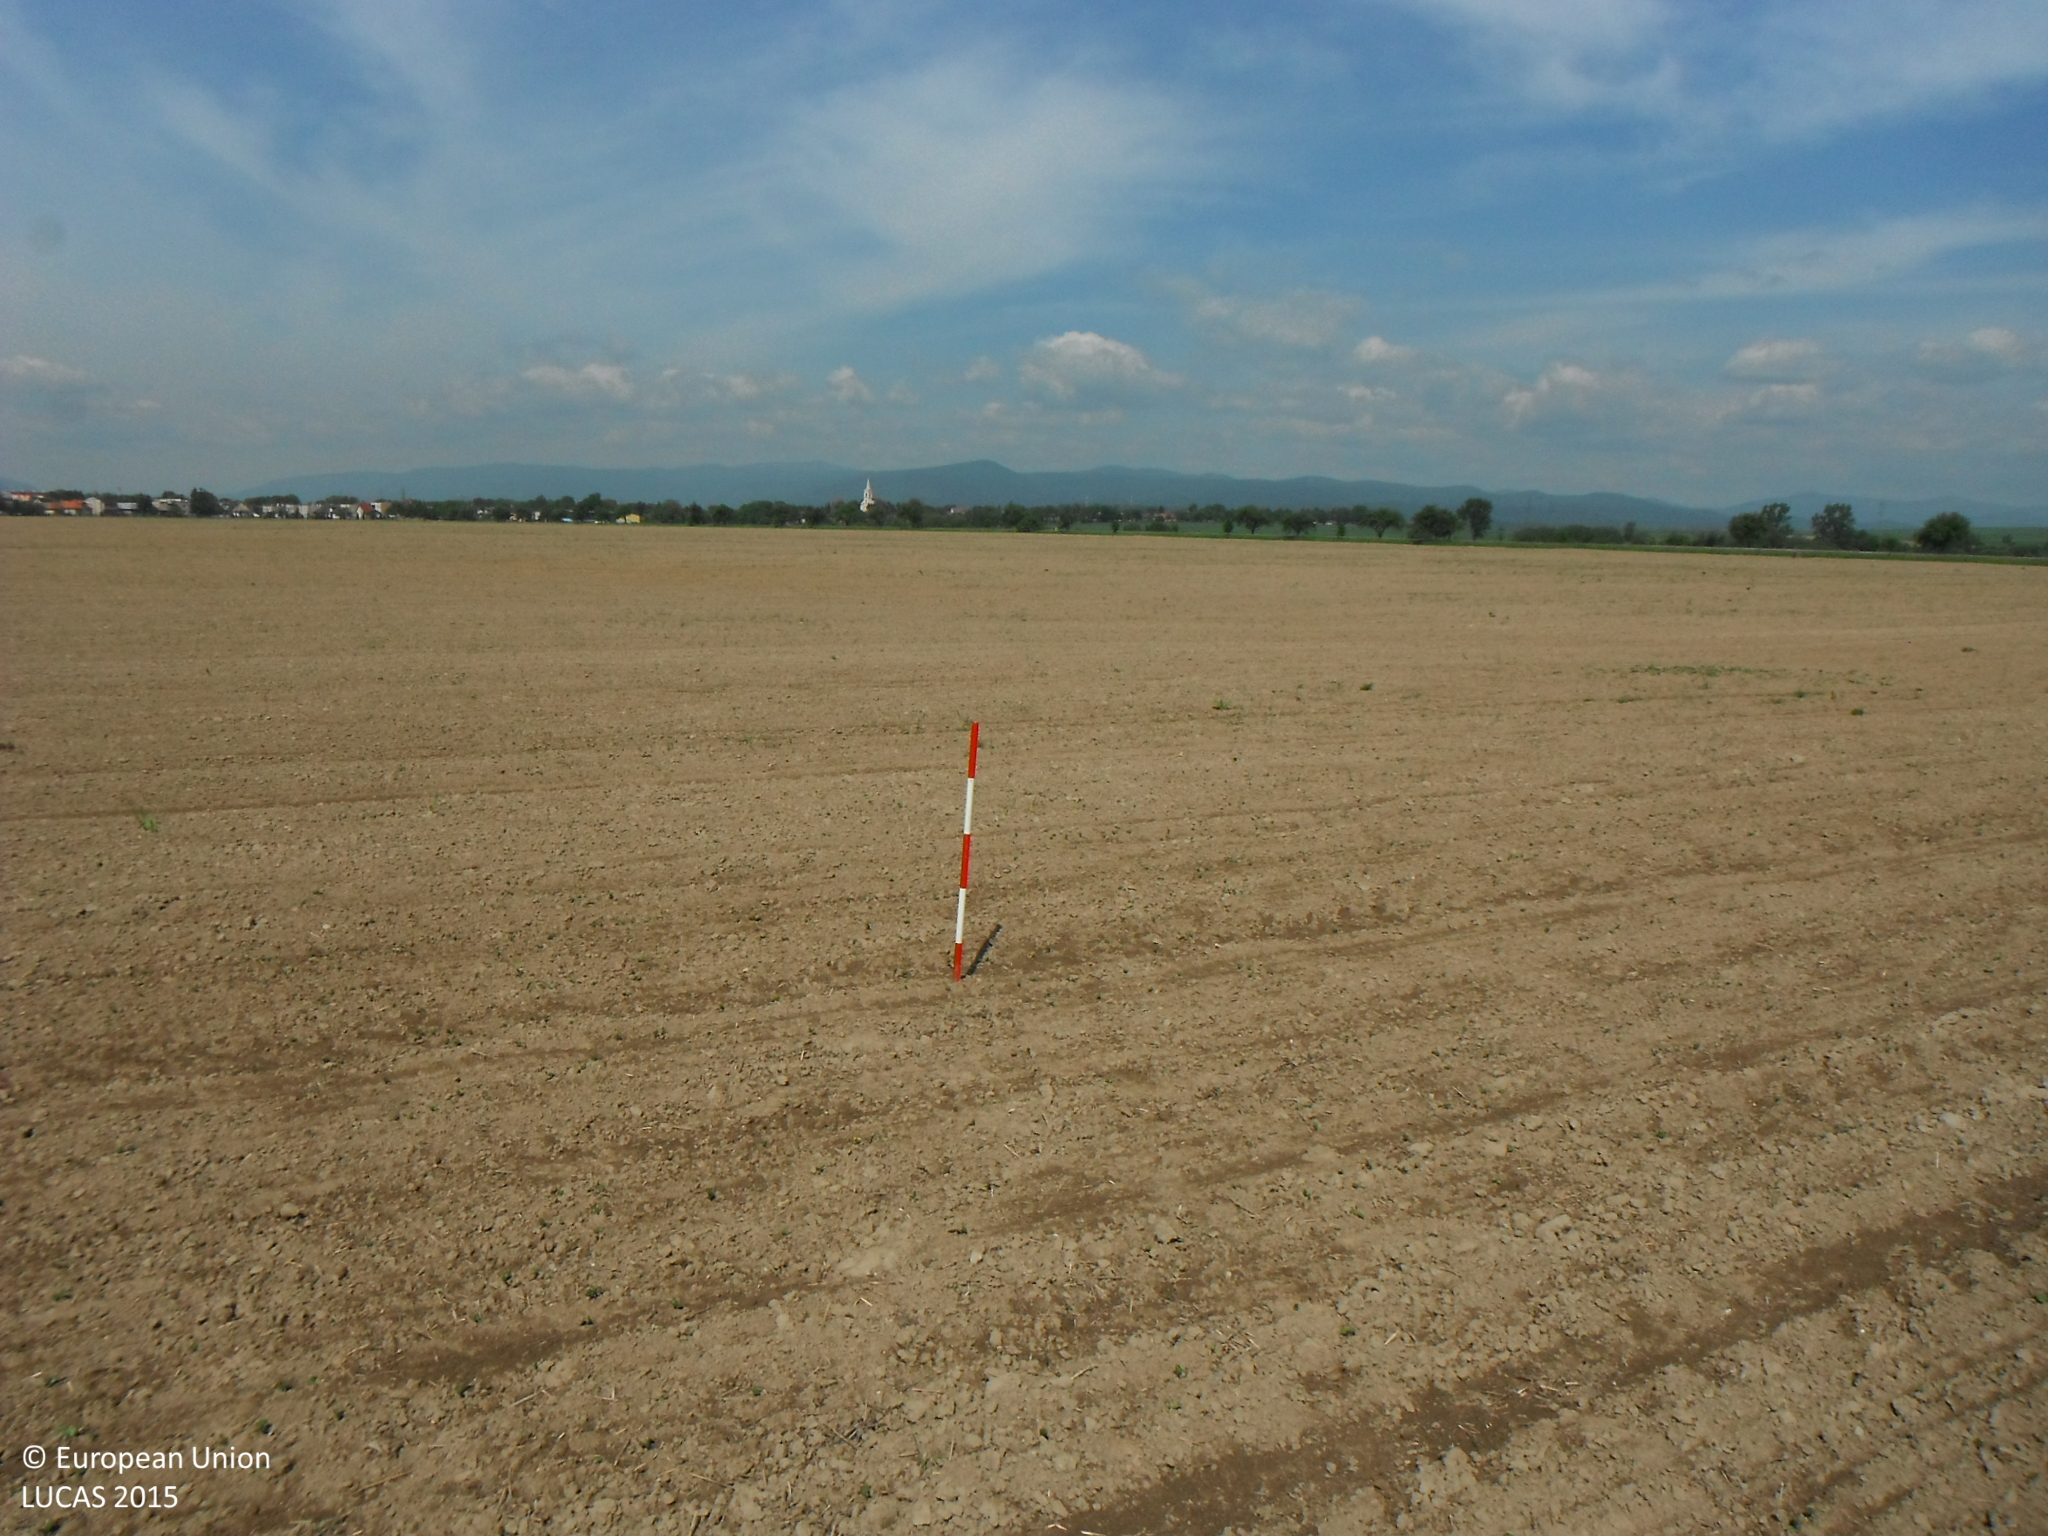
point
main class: Cropland
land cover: Soya
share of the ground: < 10 %
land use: Agriculture (excluding fallow land and kitchen gardens)
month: May
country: SK
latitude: 48.5936
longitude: 21.0375
